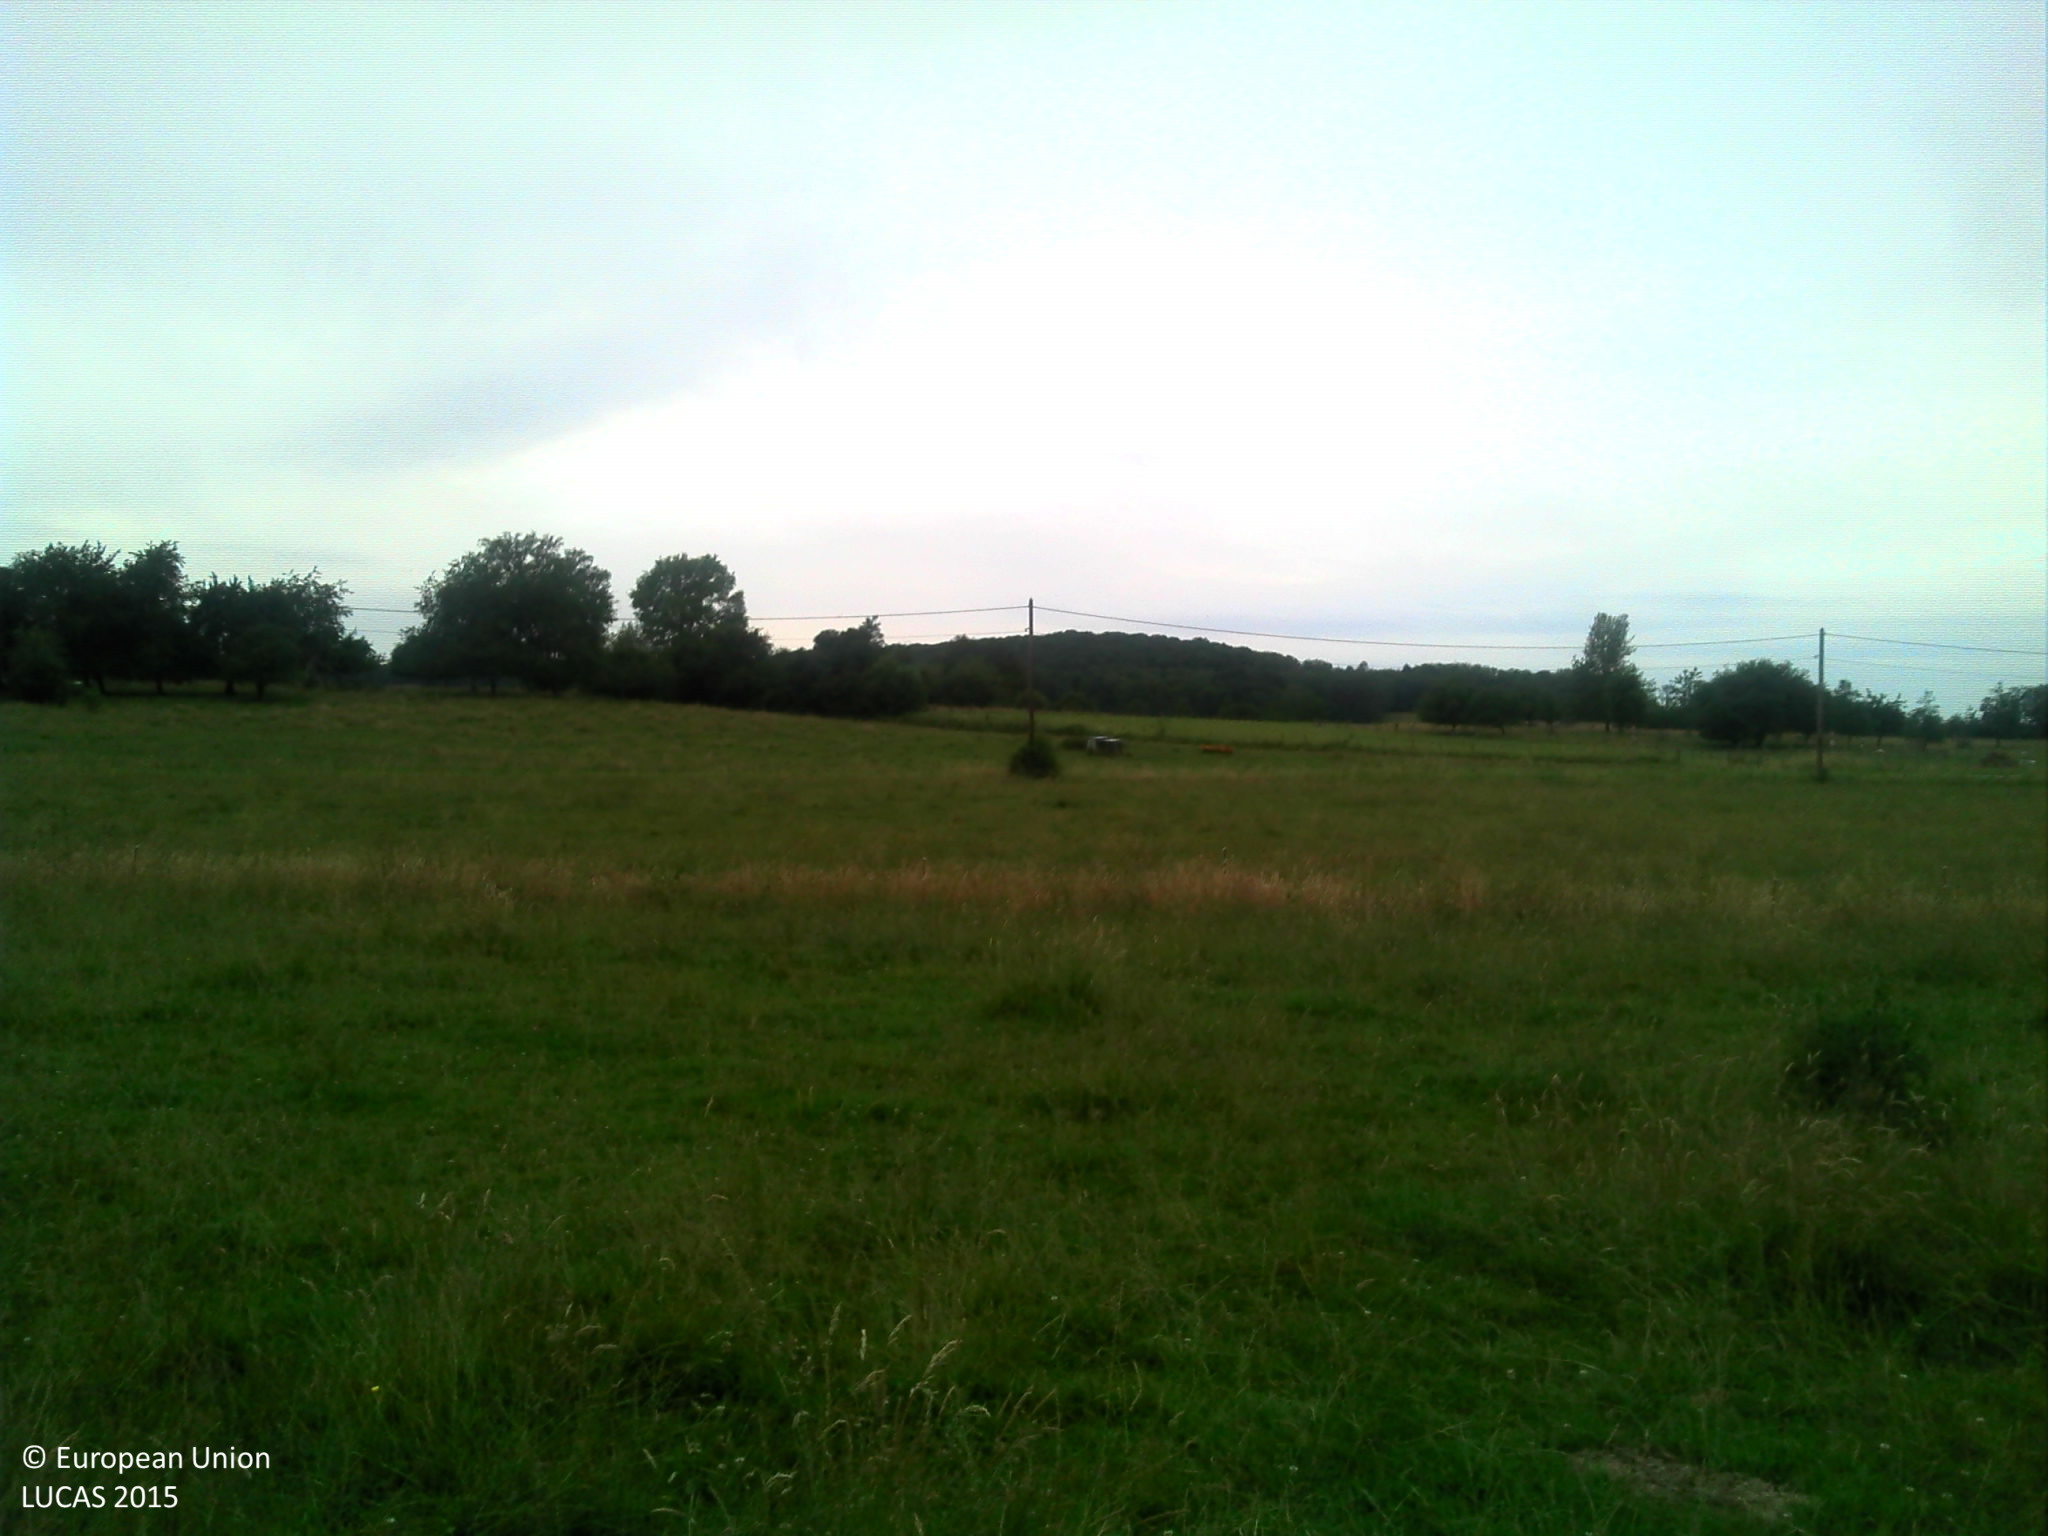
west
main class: Grassland
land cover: Grassland without tree/shrub cover
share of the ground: > 75 %
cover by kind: herbaceous plants 100 %
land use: Agriculture (excluding fallow land and kitchen gardens)
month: June
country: FR
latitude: 47.8561
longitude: 6.3255
